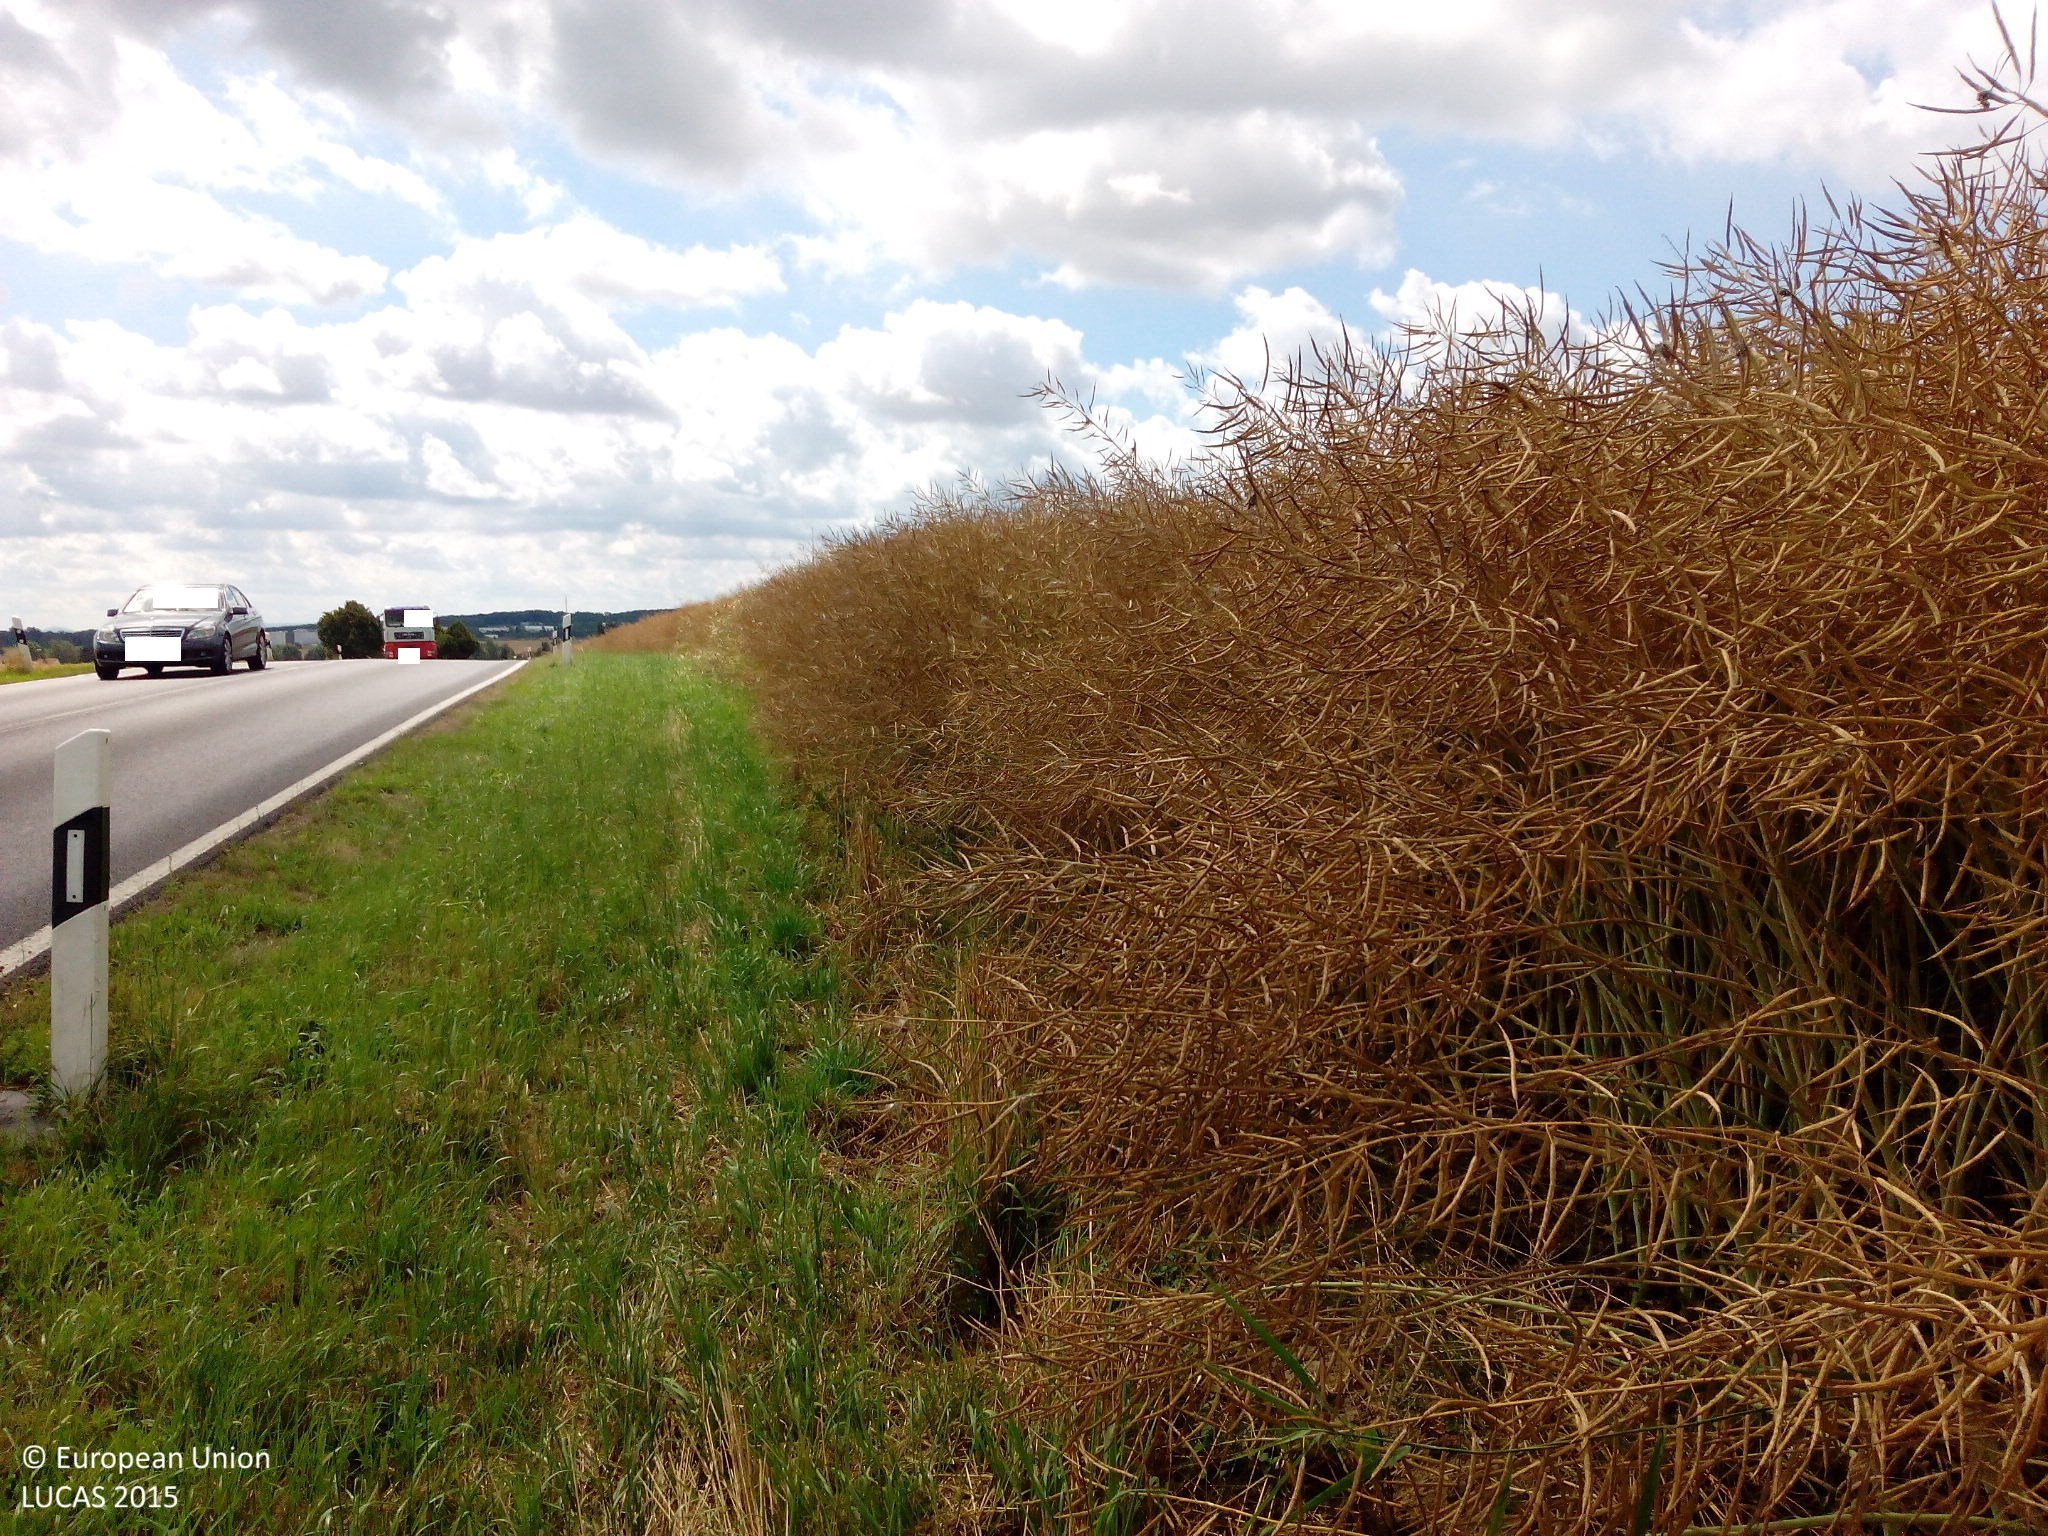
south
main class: Cropland
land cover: Rape and turnip rape
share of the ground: > 75 %
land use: Agriculture (excluding fallow land and kitchen gardens)
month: July
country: DE
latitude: 51.0845
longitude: 13.4980
